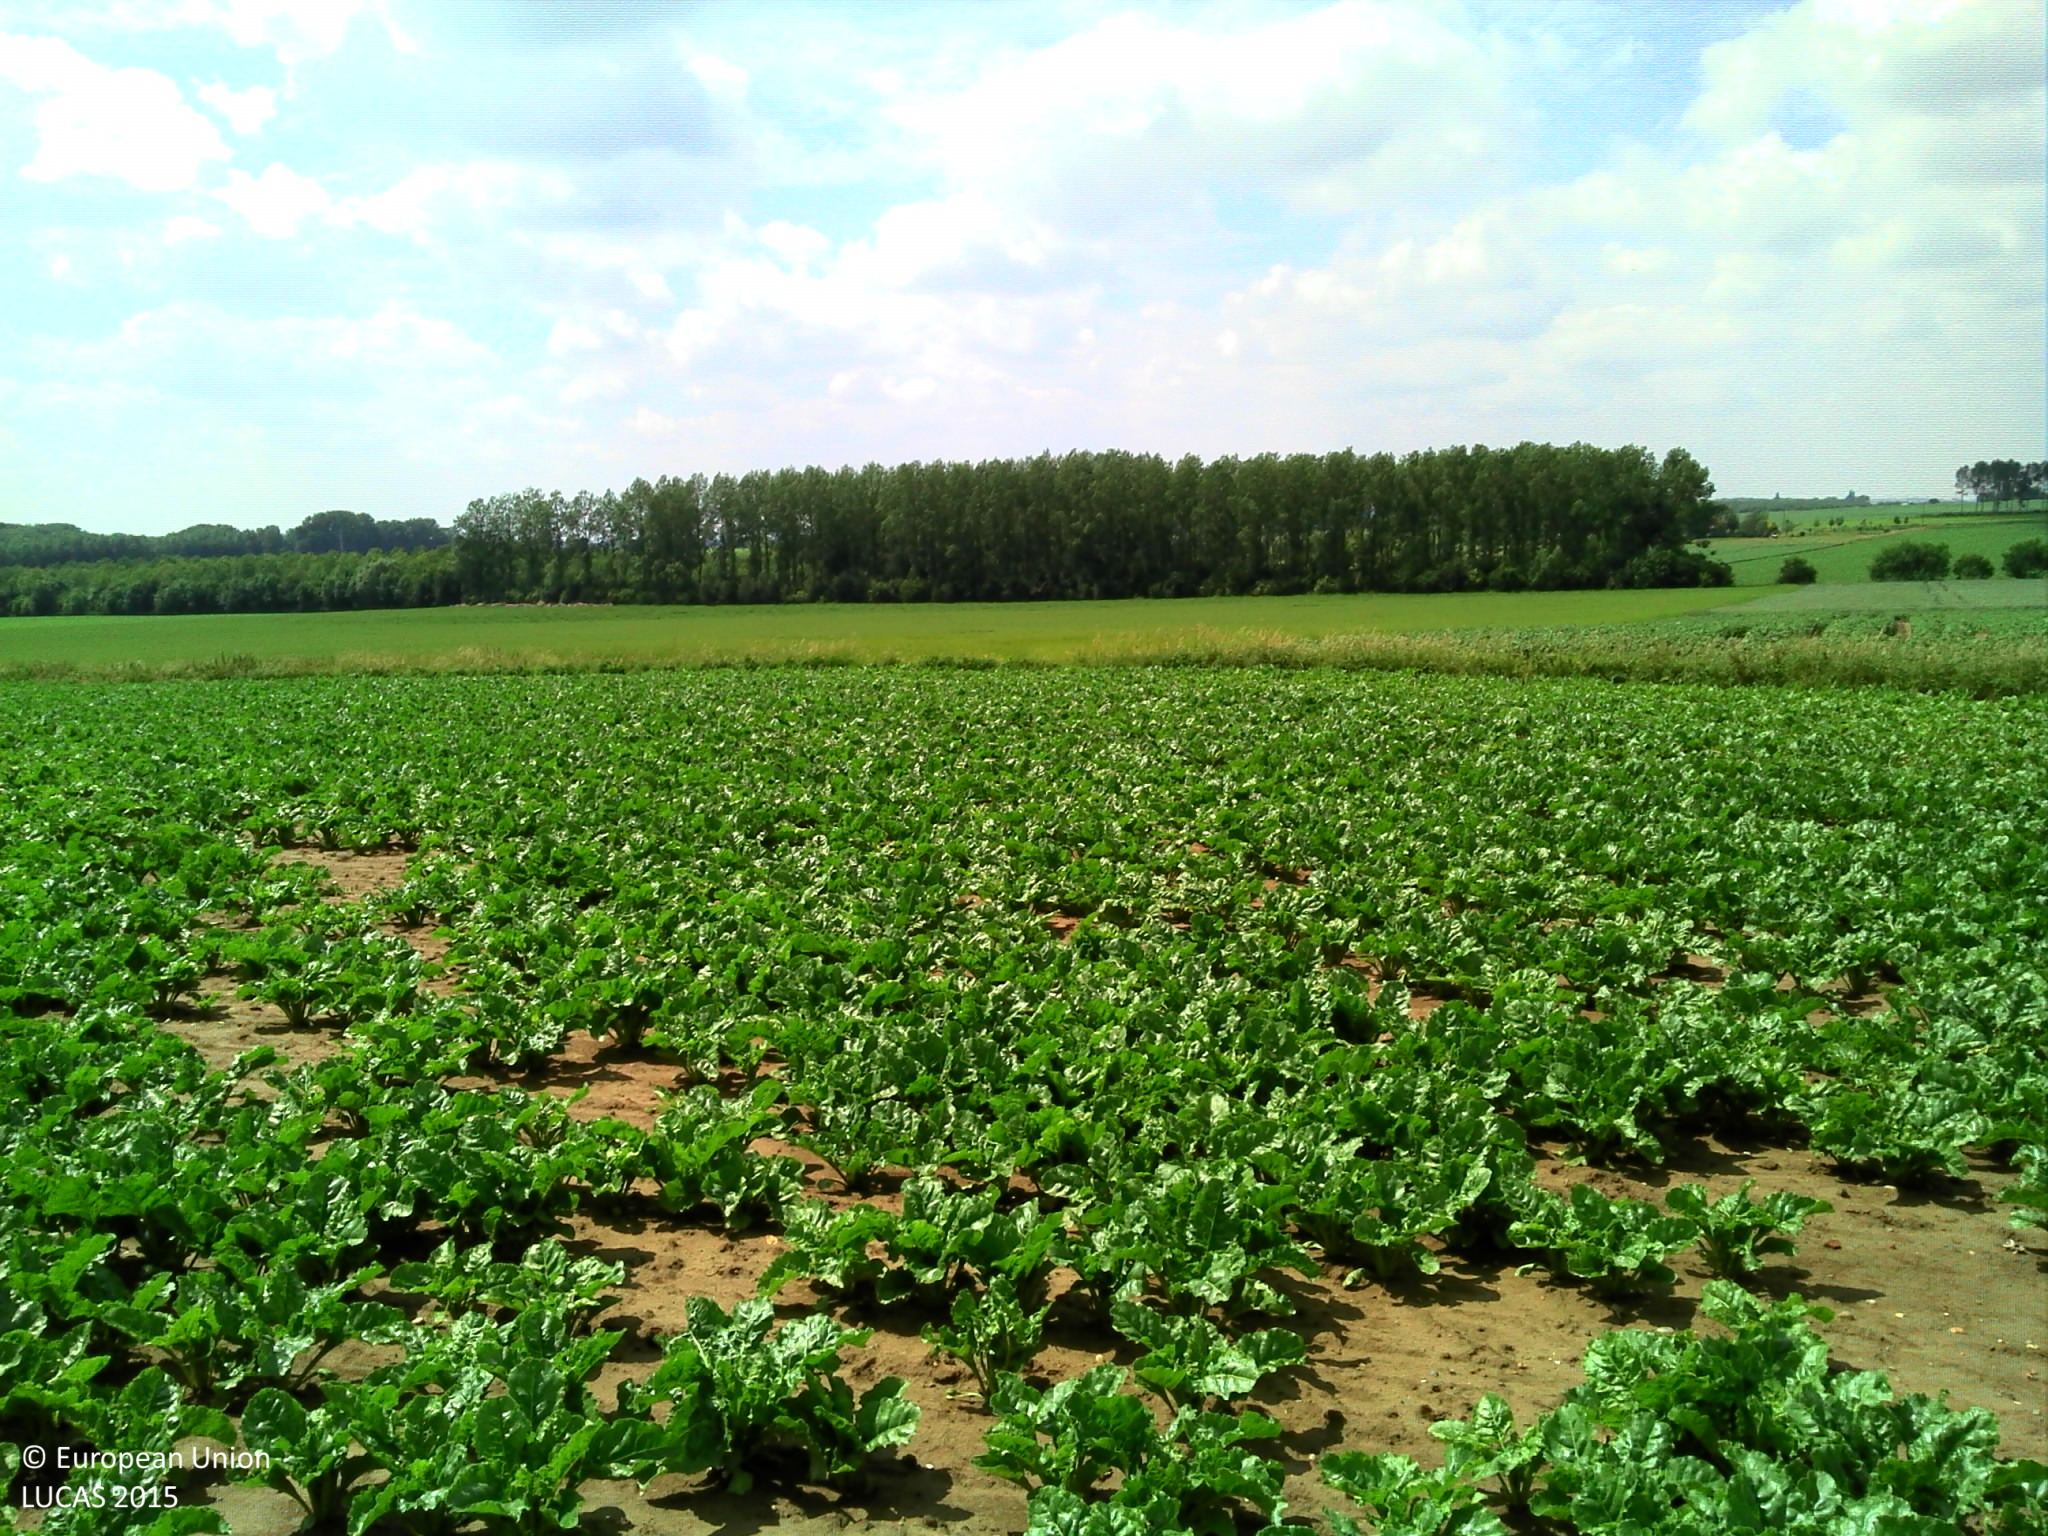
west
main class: Cropland
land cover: Sugar beet
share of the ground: 50 - 75 %
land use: Agriculture (excluding fallow land and kitchen gardens)
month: June
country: BE
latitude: 50.6146
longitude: 3.8743
